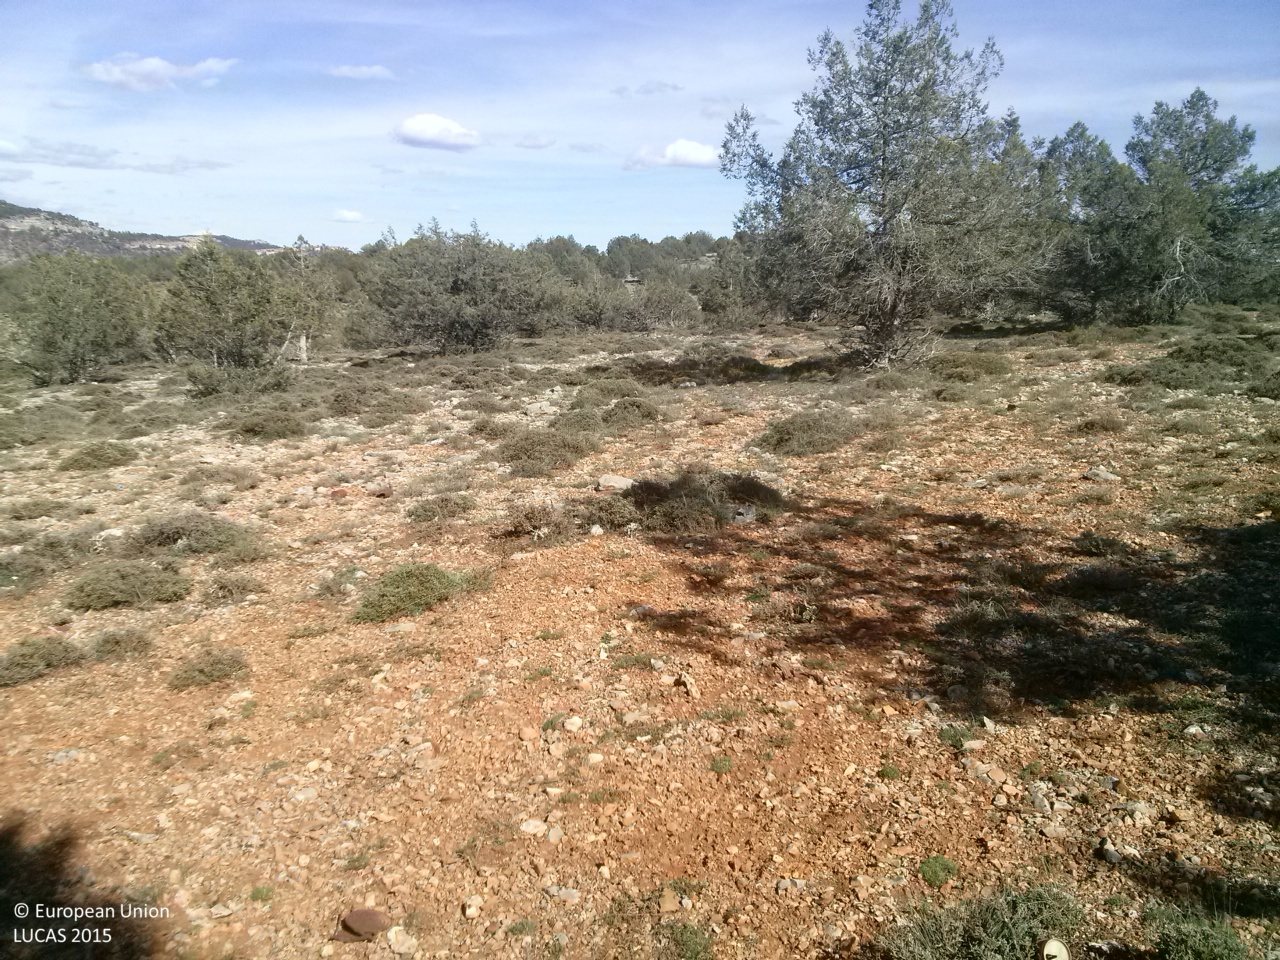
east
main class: Woodland
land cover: Other coniferous woodland
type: coniferous forest of the mediterranean region
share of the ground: 10 - 25 %
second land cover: Grassland without tree/shrub cover
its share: 25 - 50 %
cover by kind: unconsolidated bare surface 50 %, herbaceous plants 30 %, coniferous forest trees 15 %, shrubs 5 %
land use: Forestry
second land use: Agriculture (excluding fallow land and kitchen gardens)
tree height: < 5 m
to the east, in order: Other coniferous woodland; Grassland without tree/shrub cover; Other coniferous woodland; Rock outcrops; Rivers and streams; Rock outcrops; Other coniferous woodland; Rocks and stones; Pine dominated mixed woodland
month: April
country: ES
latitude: 40.0963
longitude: -1.6833
